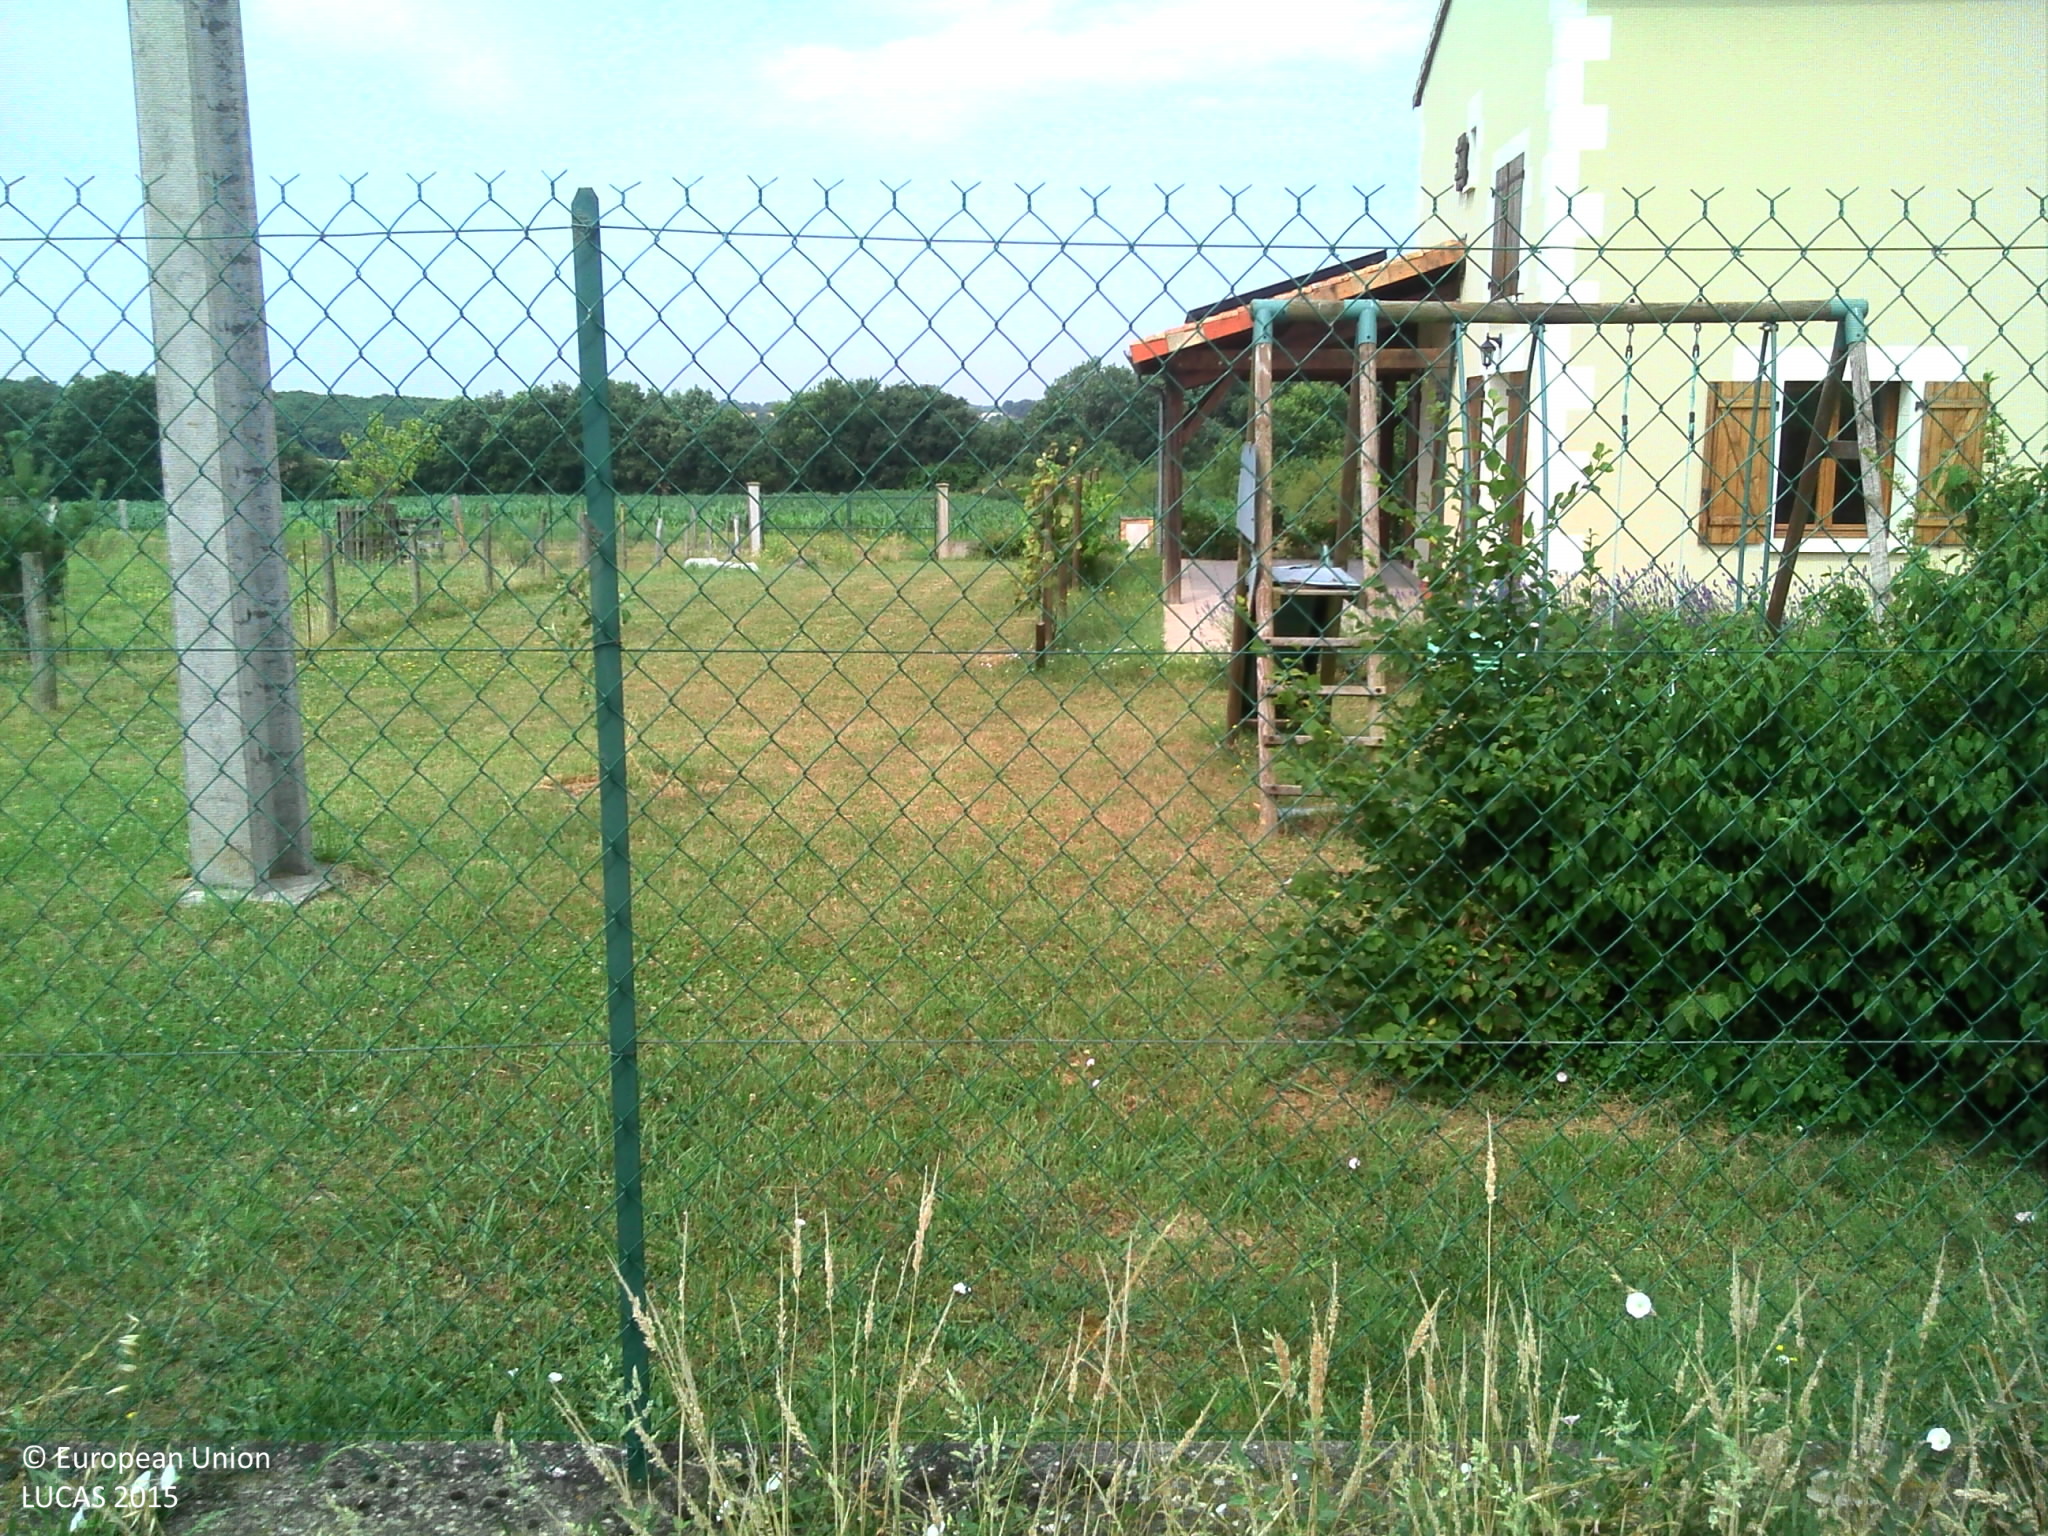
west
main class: Grassland
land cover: Grassland without tree/shrub cover
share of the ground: > 75 %
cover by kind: herbaceous plants 100 %
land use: Residential
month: July
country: FR
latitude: 46.4640
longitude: 0.6211
